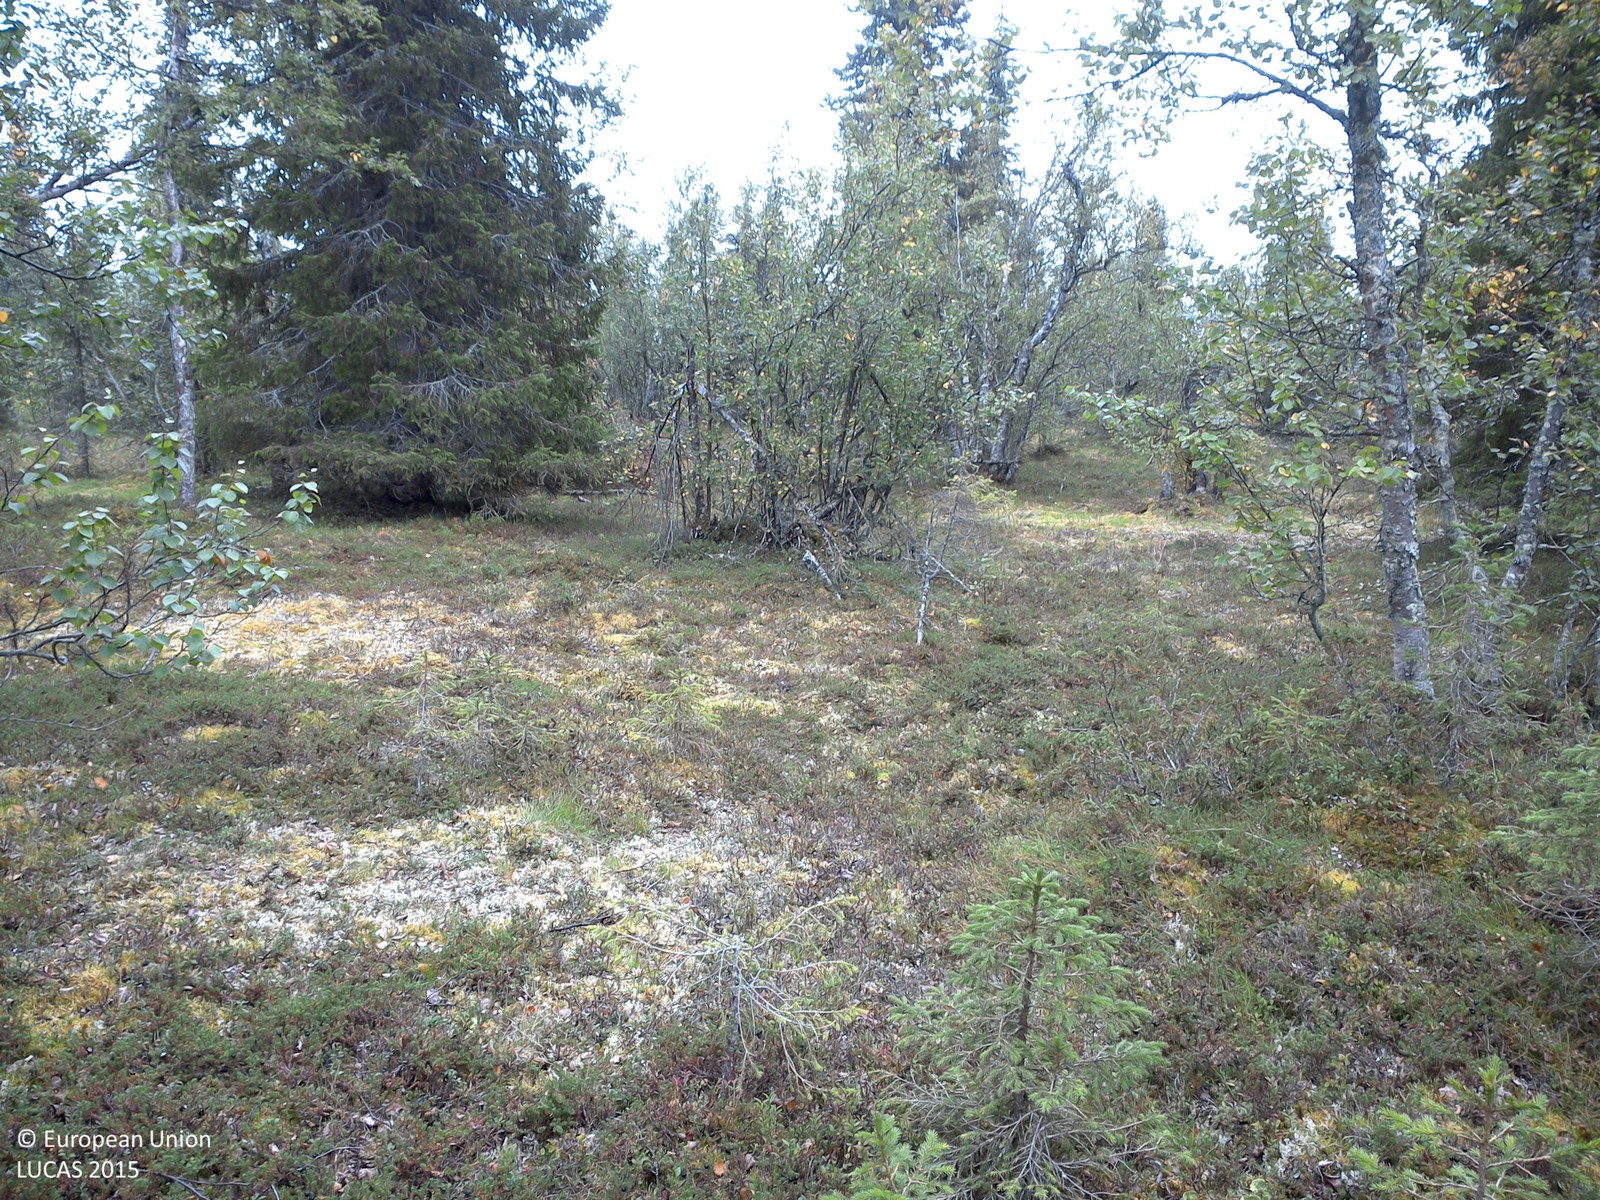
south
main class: Woodland
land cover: Spruce dominated mixed woodland
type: boreal forest
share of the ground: 25 - 50 %
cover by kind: shrubs 50 %, coniferous forest trees 20 %, broadleaved forest trees 15 %, lichens and mosses 15 %
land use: Amenities, museums, leisure
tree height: > 5 m
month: August
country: SE
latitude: 67.9966
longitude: 22.2659
